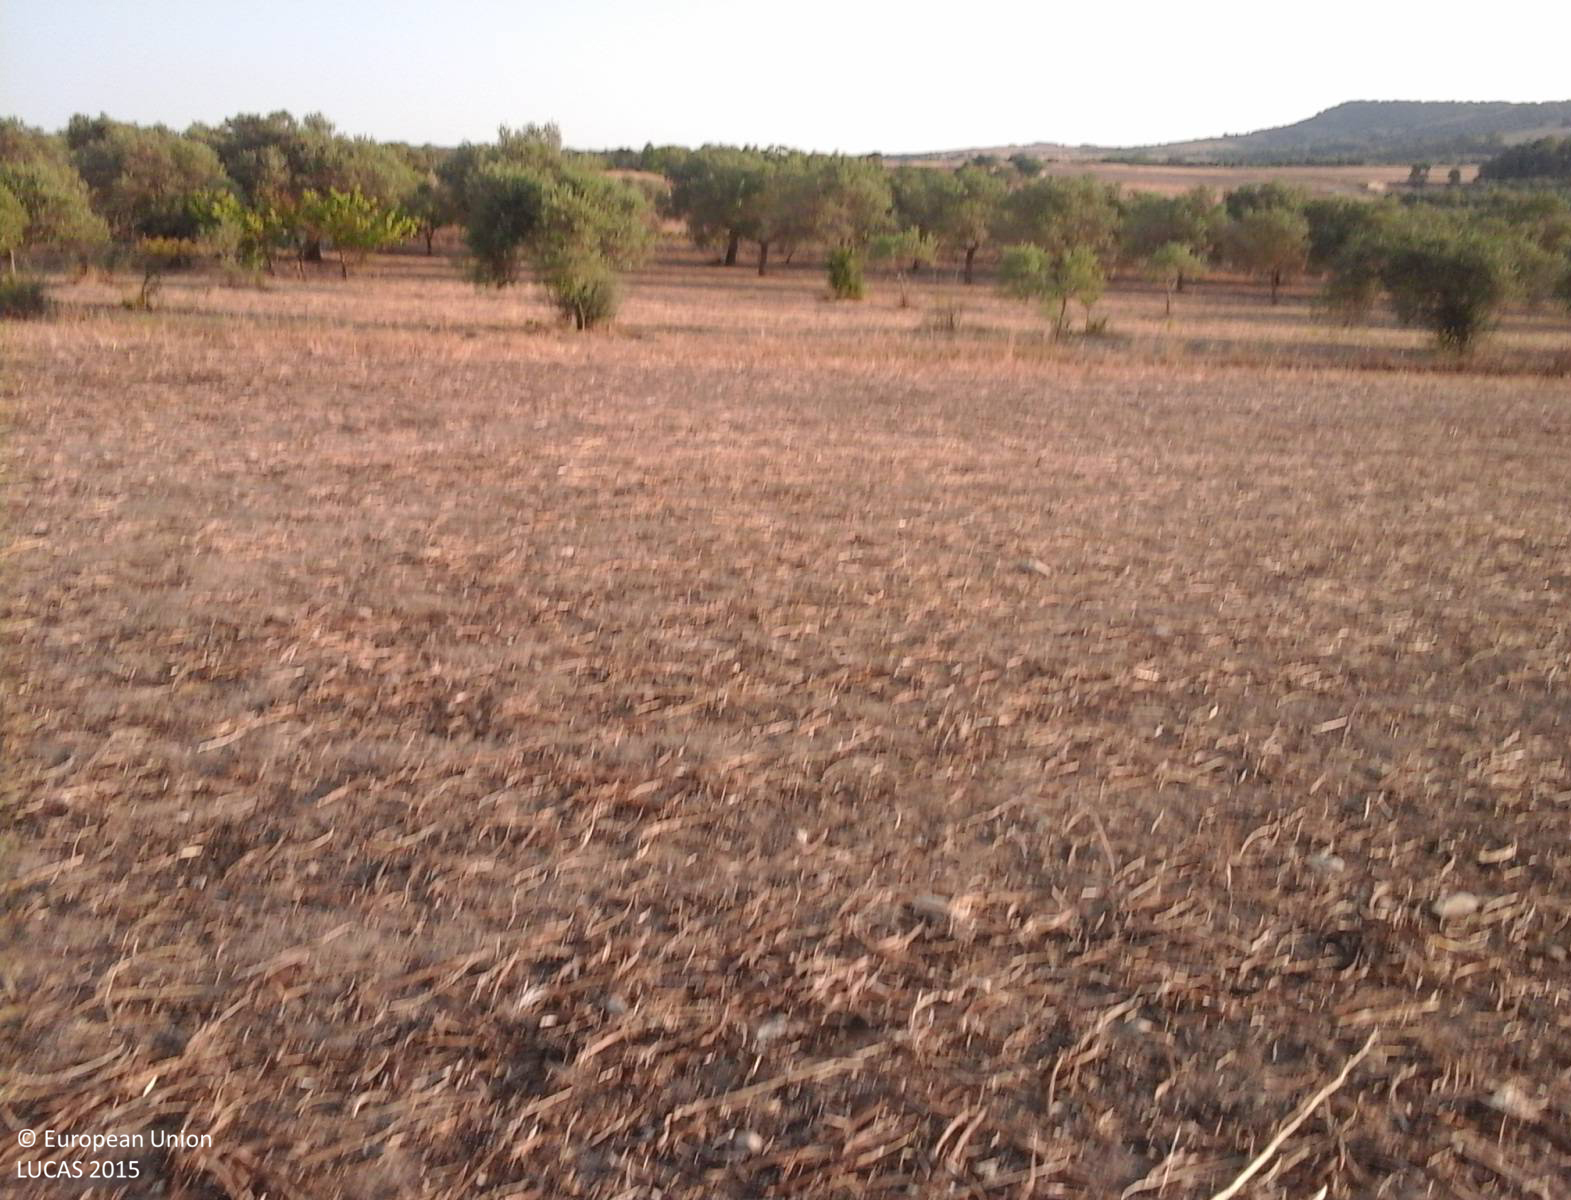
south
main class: Cropland
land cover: Dry pulses
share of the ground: > 75 %
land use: Agriculture (excluding fallow land and kitchen gardens)
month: July
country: IT
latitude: 39.6998
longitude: 8.8984
